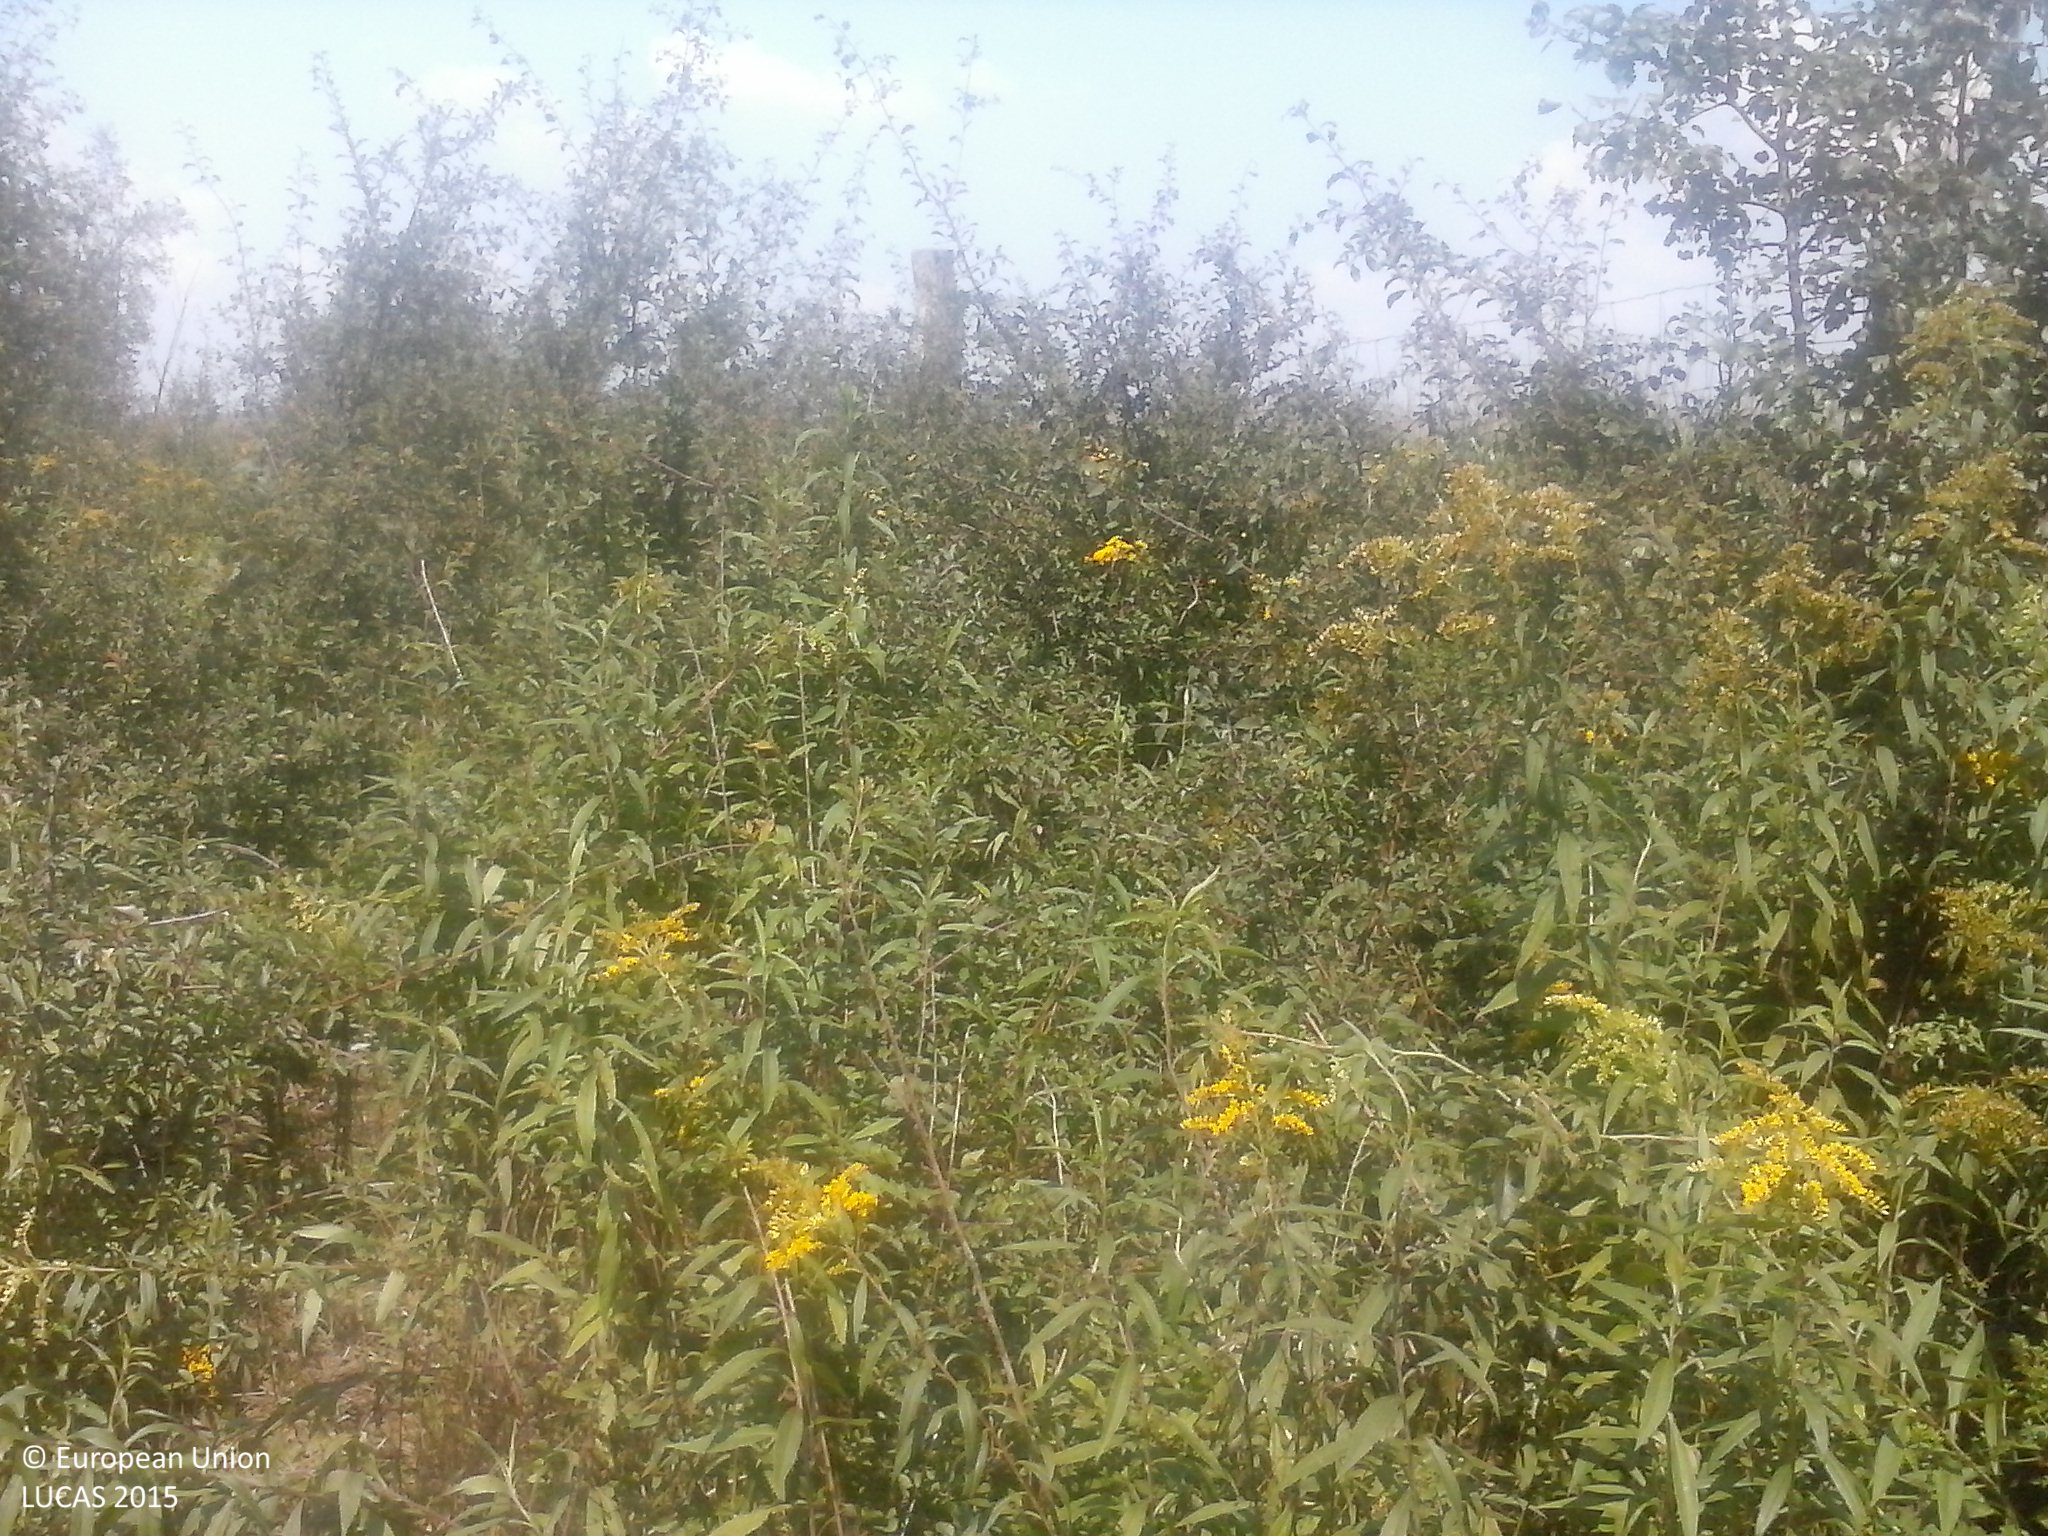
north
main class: Cropland
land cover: Maize
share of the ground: > 75 %
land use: Agriculture (excluding fallow land and kitchen gardens)
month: August
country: HU
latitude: 45.9247
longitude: 17.7540
